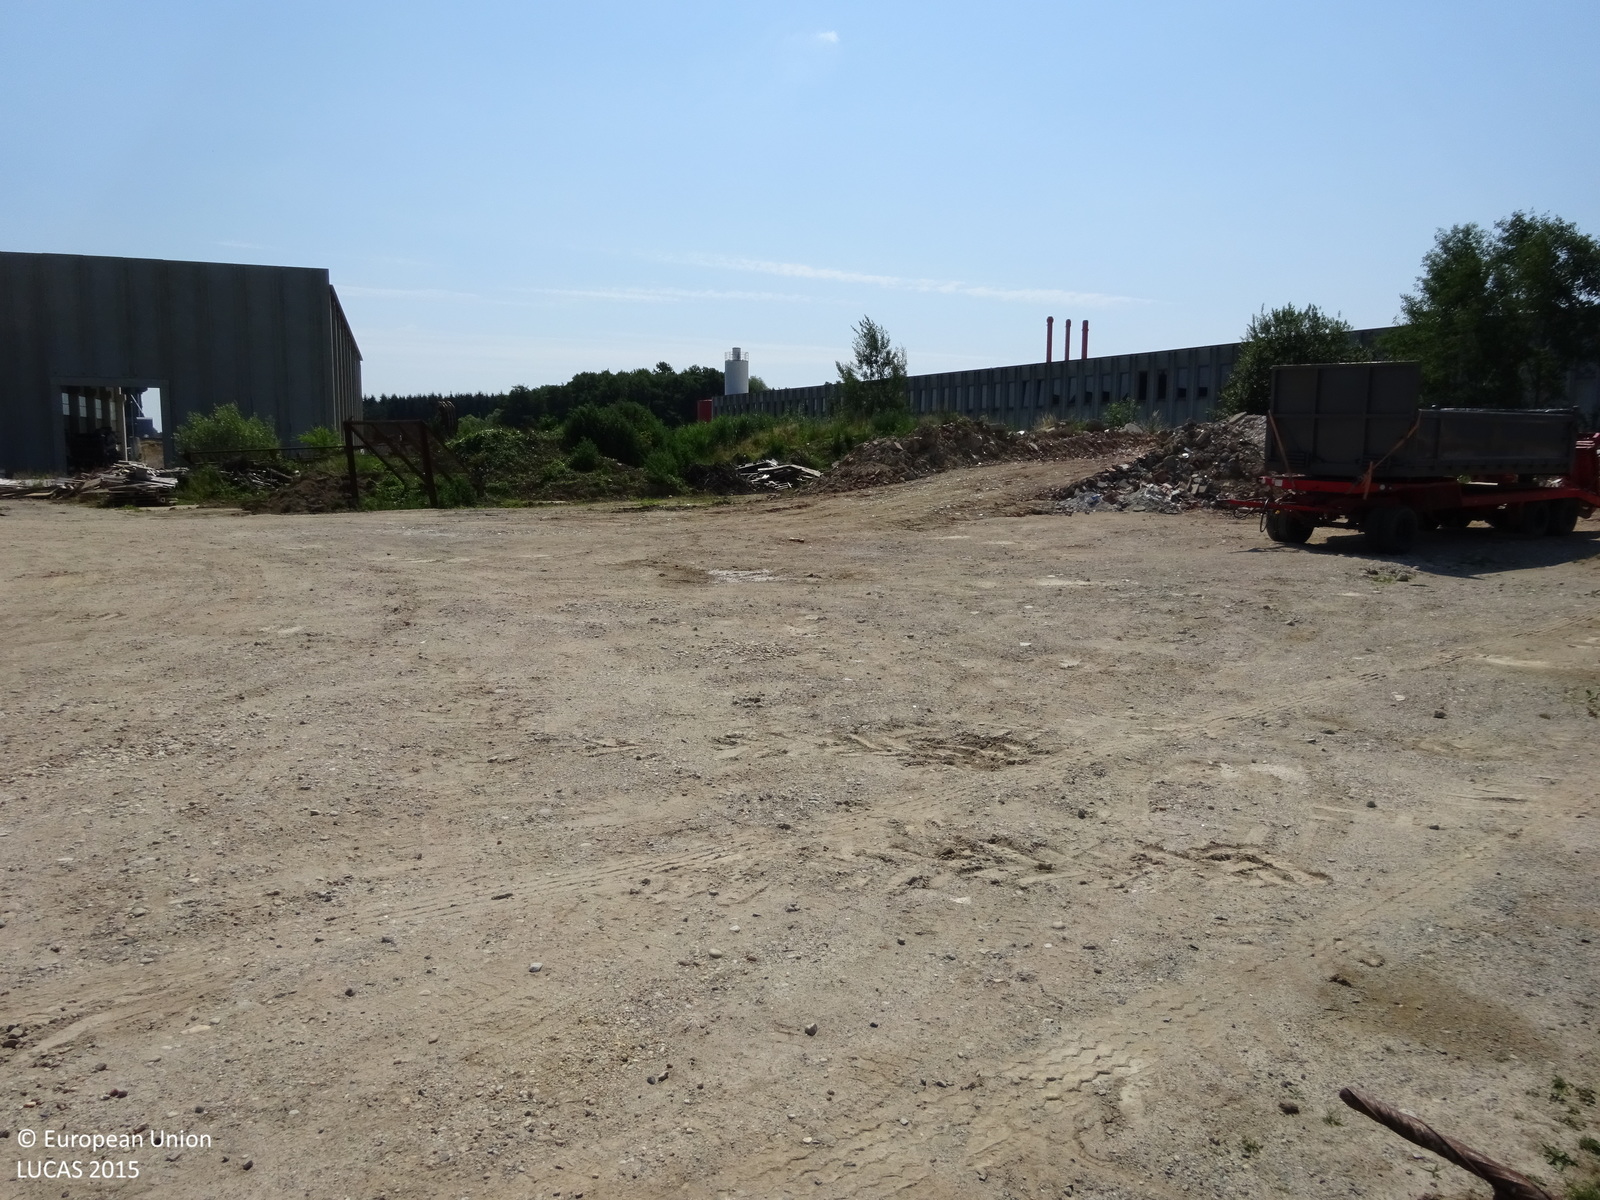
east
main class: Grassland
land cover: Spontaneously vegetated surfaces
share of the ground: 25 - 50 %
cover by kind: herbaceous plants 60 %, consolidated bare surface 20 %, unconsolidated bare surface 20 %
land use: Construction
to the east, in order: Spontaneously vegetated surfaces; Artificial constructions in urban areas
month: July
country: AT
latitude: 46.9335
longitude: 16.1352
